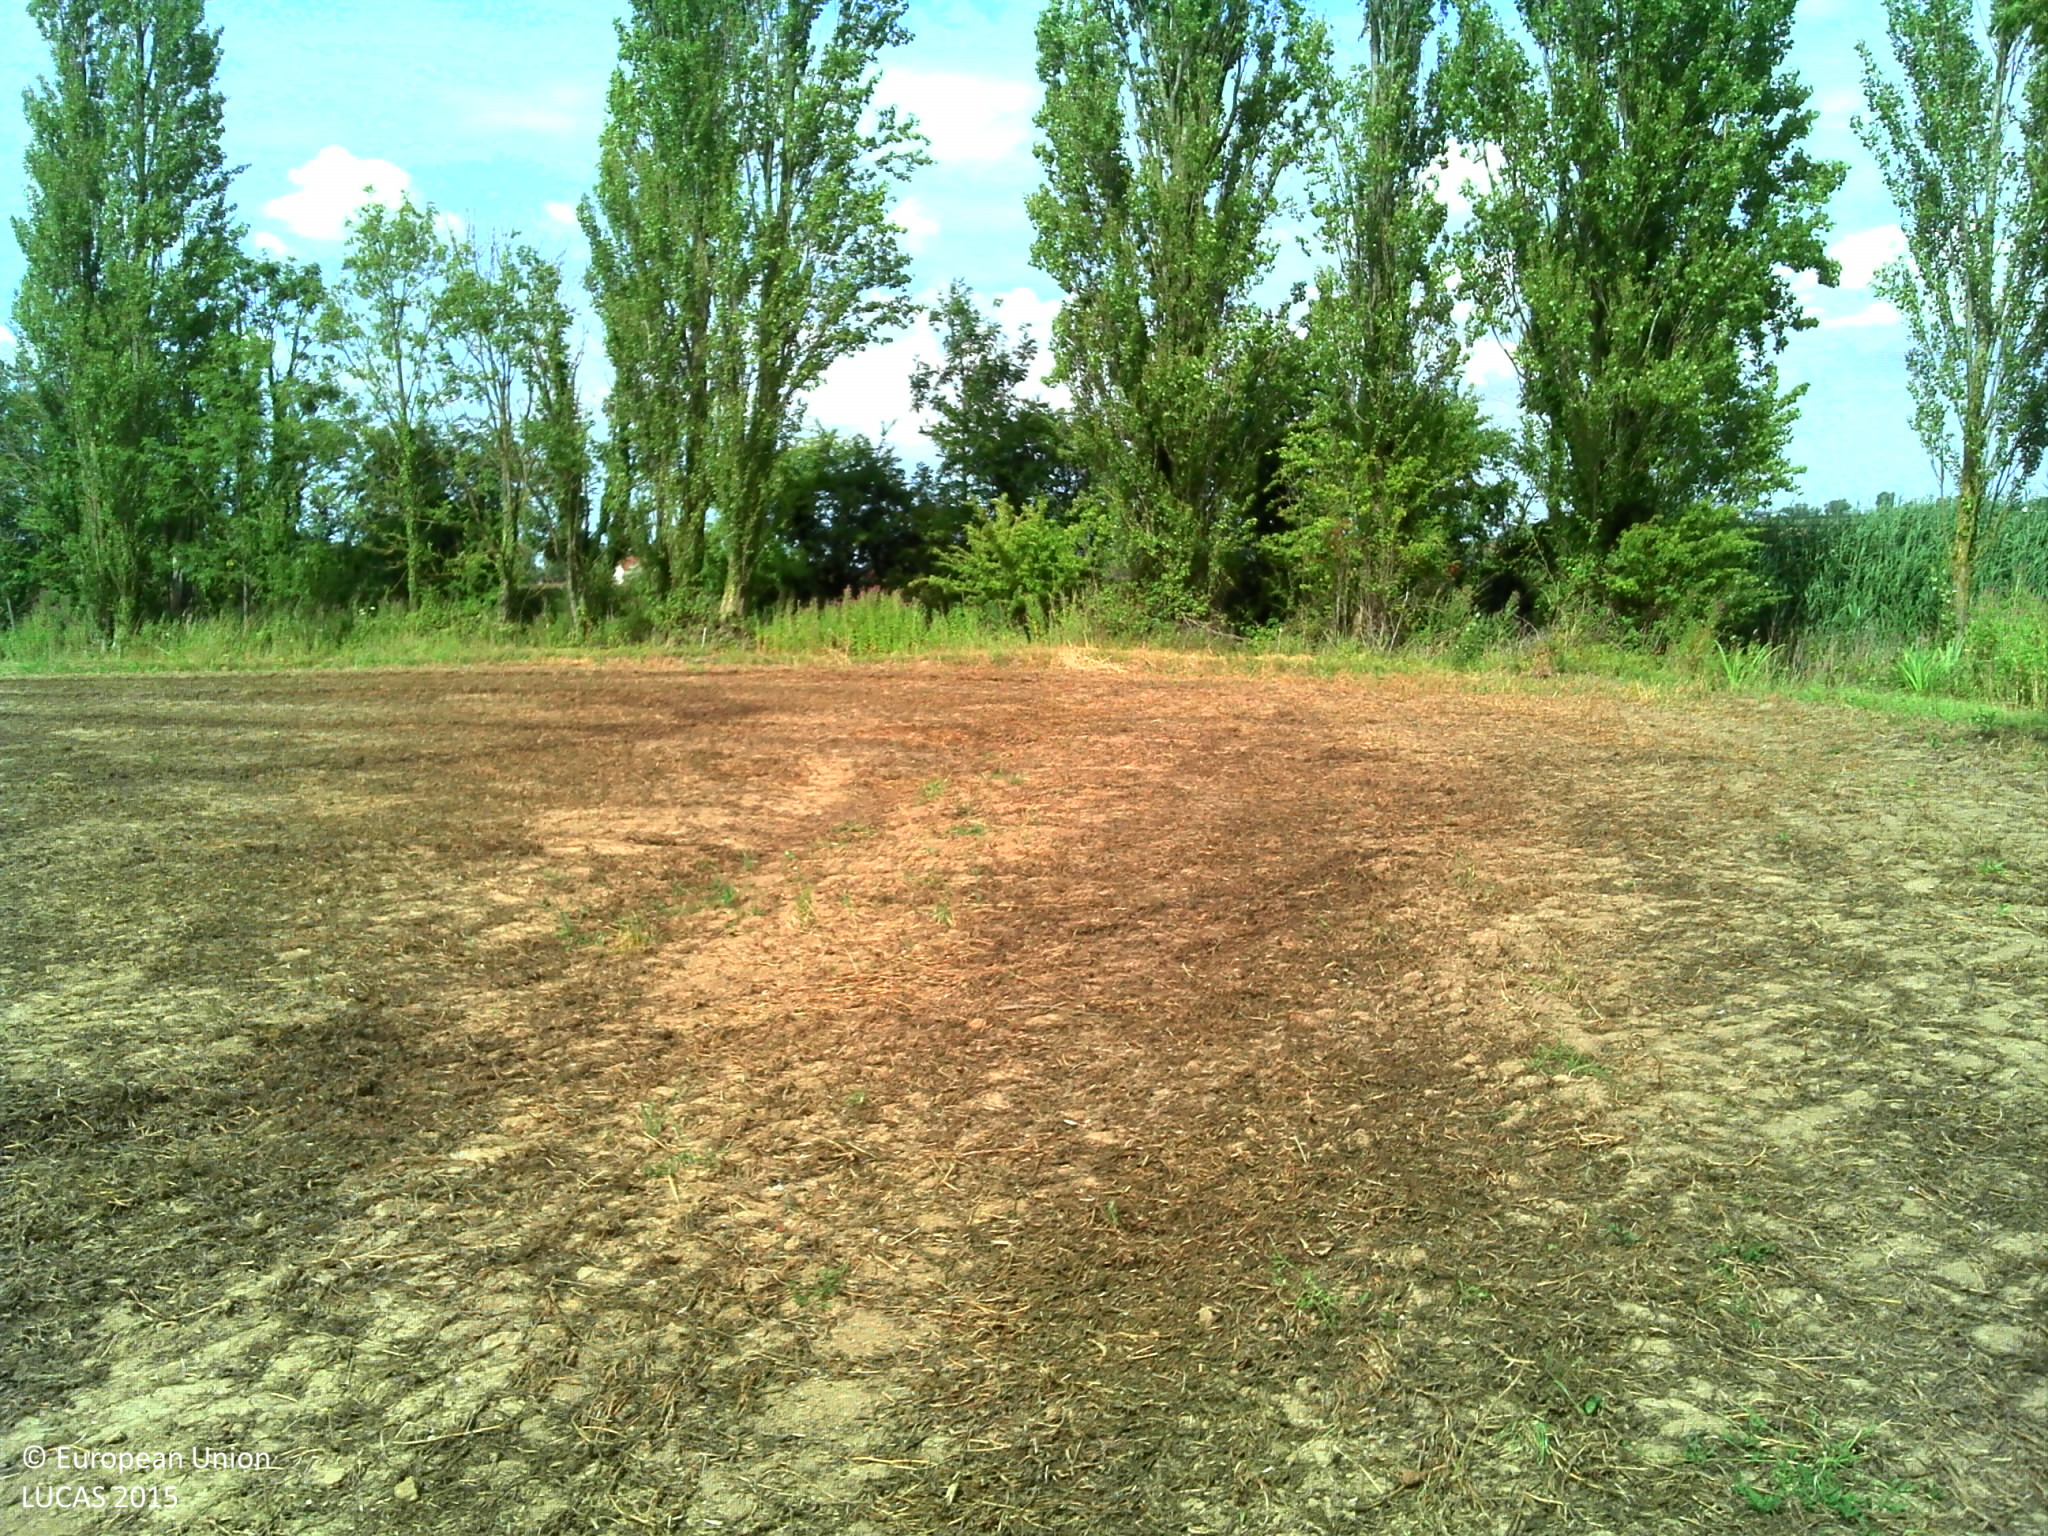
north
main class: Cropland
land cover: Dry pulses
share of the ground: < 10 %
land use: Agriculture (excluding fallow land and kitchen gardens)
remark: Harvested field
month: July
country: FR
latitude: 50.7971
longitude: 2.3962
